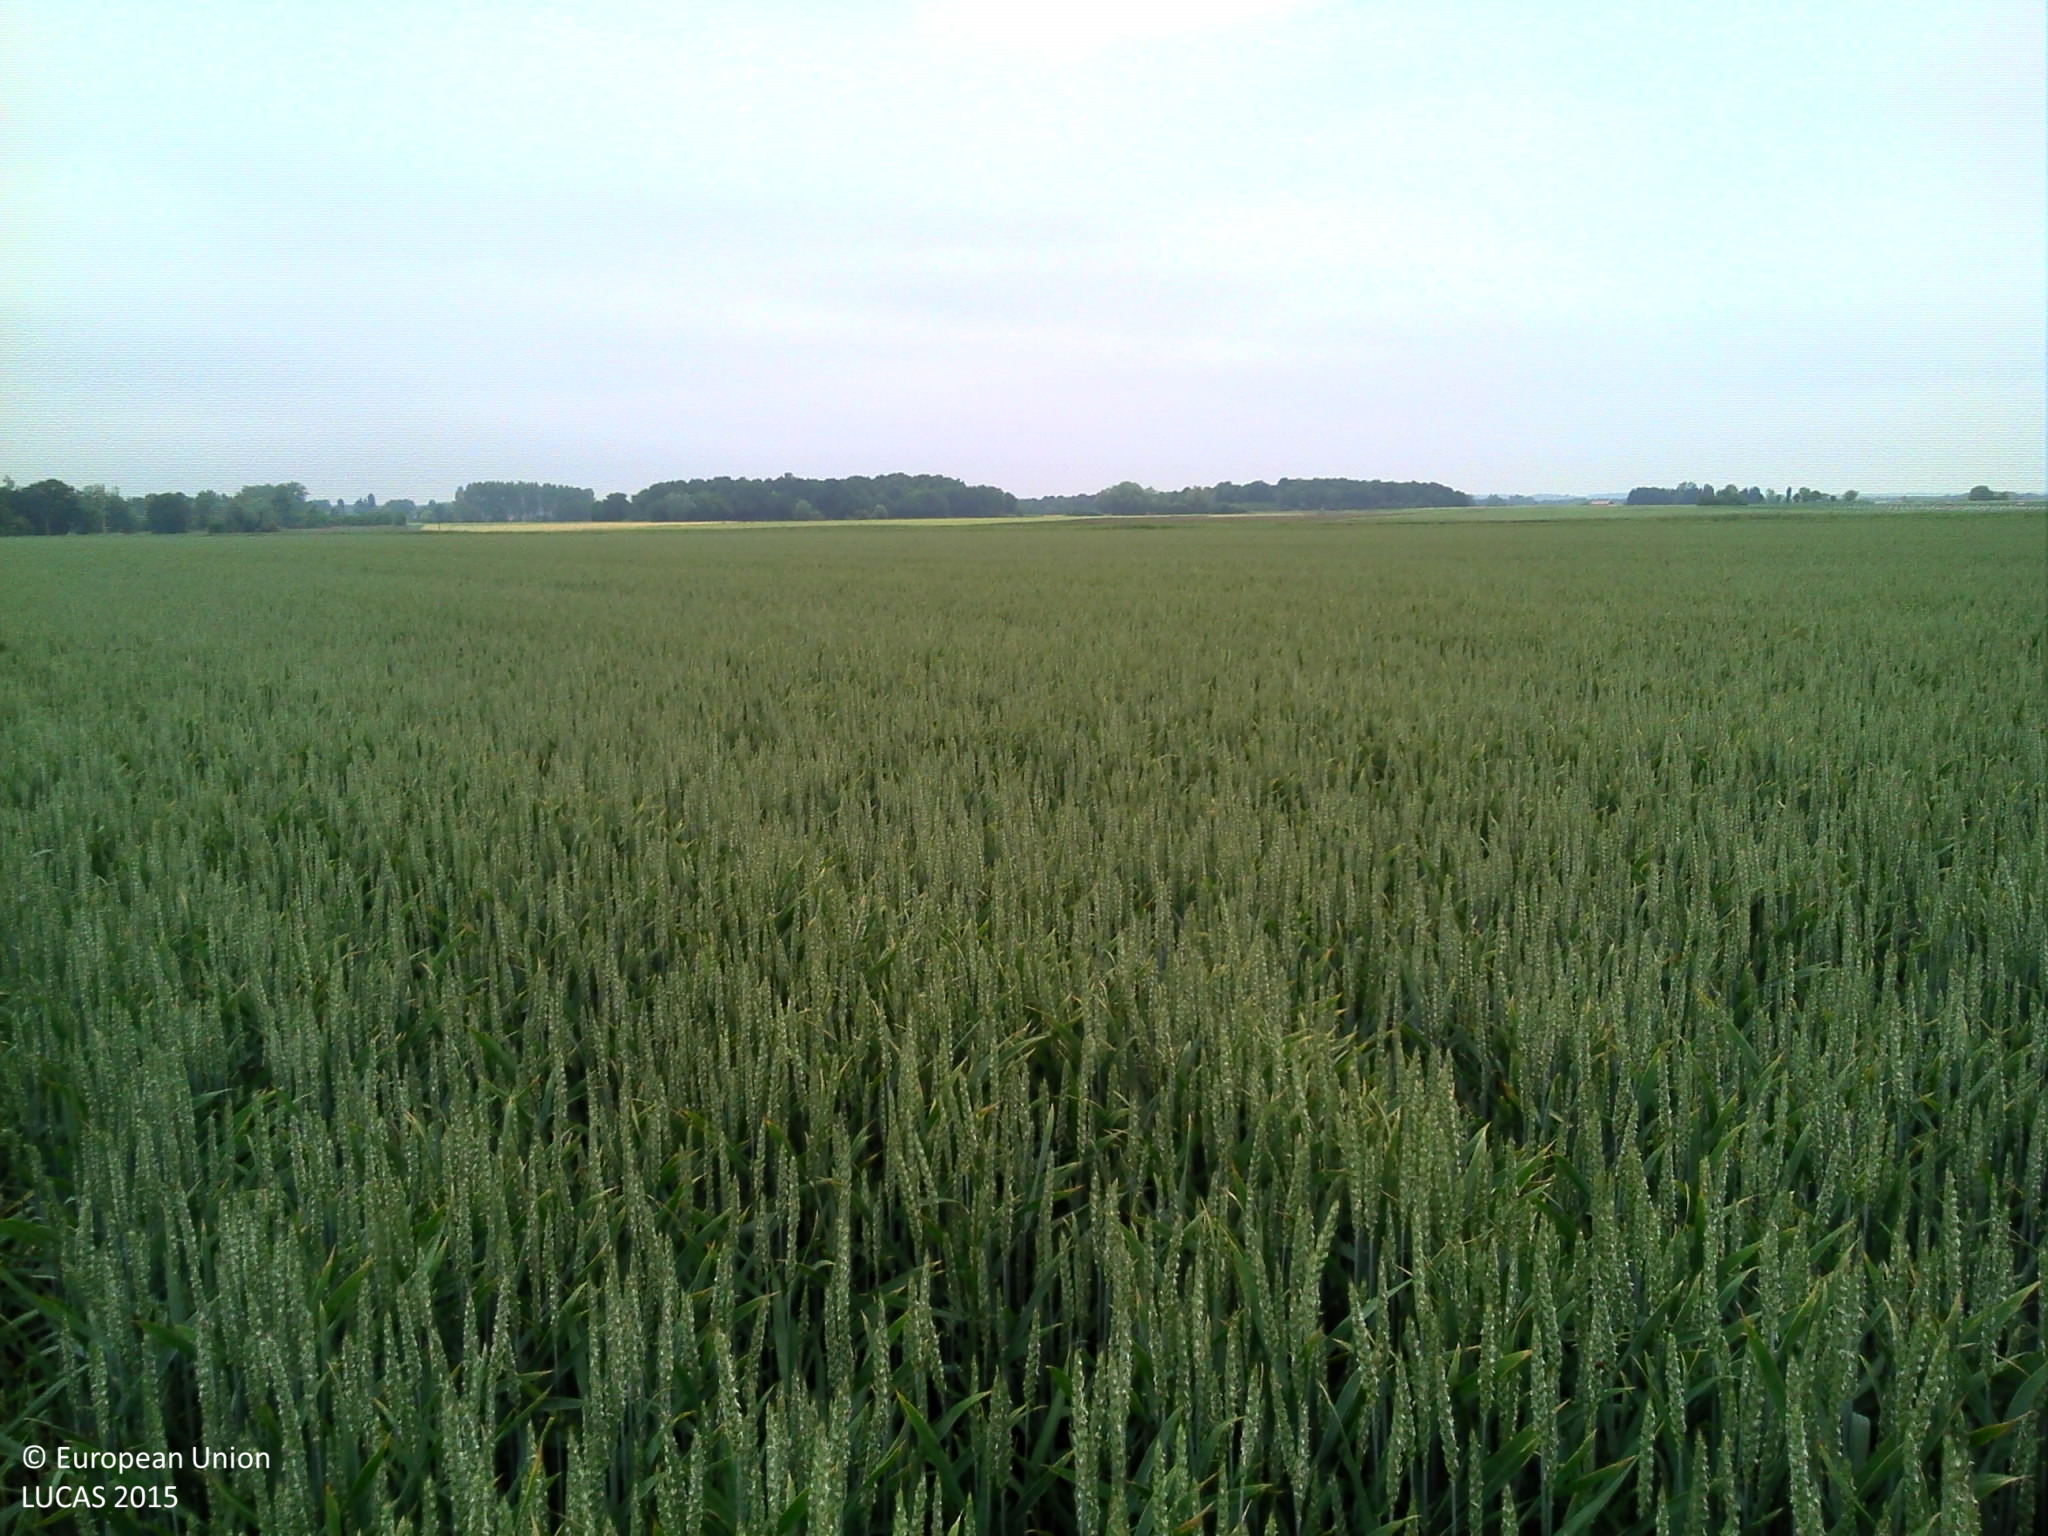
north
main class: Cropland
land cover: Common wheat
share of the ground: > 75 %
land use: Agriculture (excluding fallow land and kitchen gardens)
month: May
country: FR
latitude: 47.0686
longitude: 0.0875
